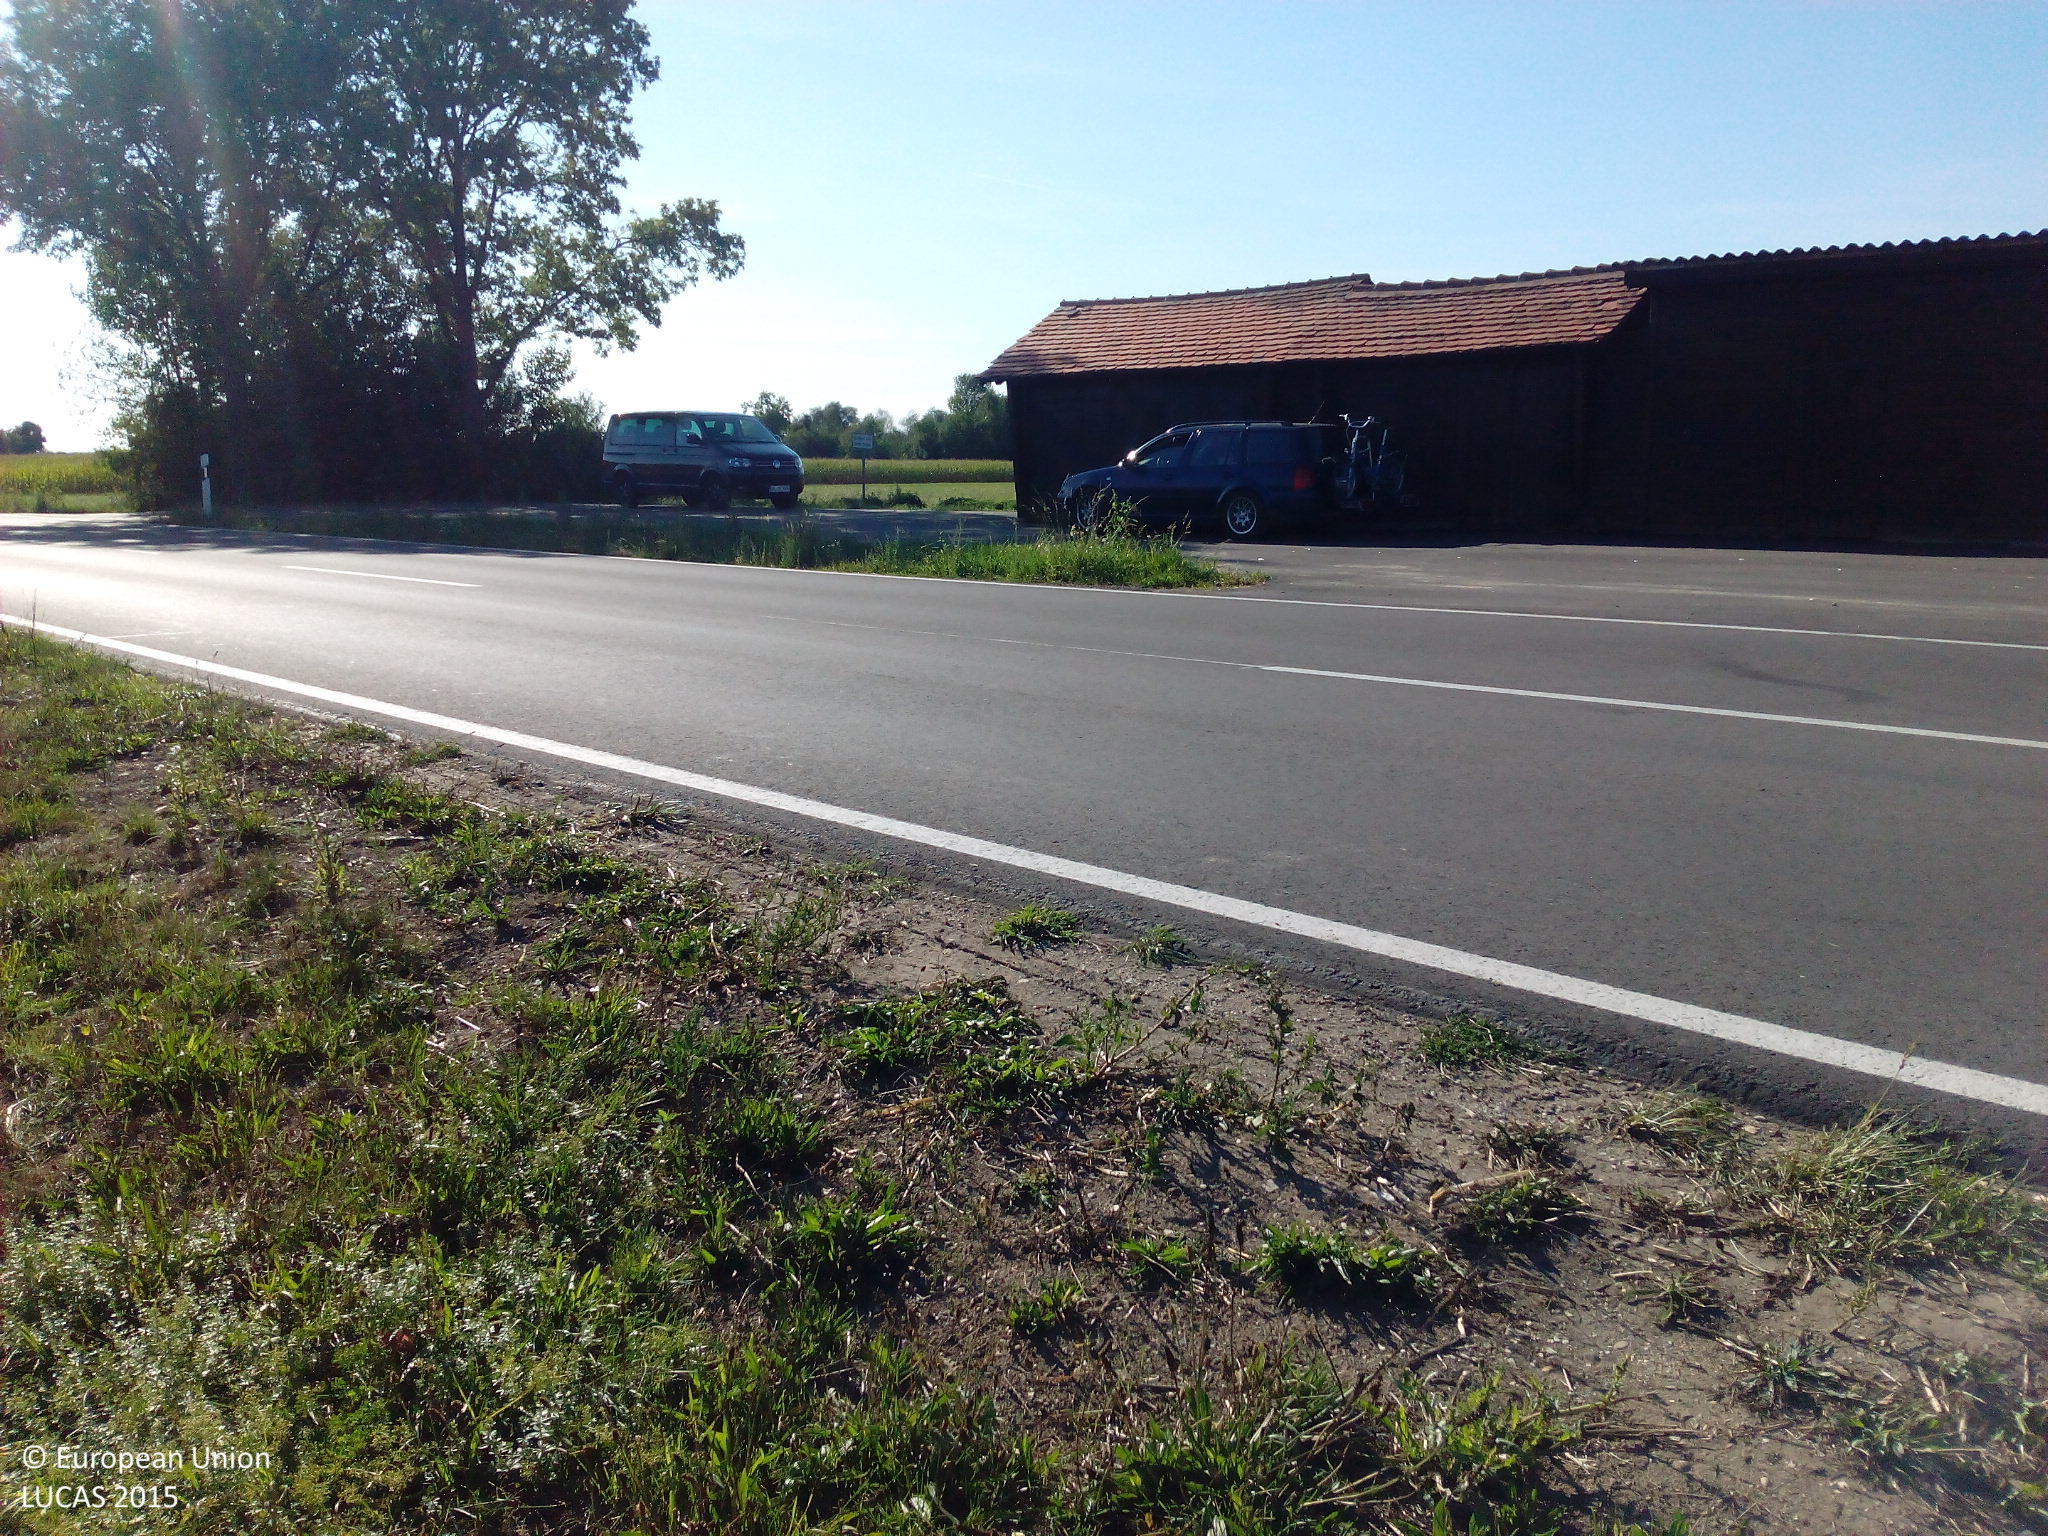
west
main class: Cropland
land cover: Maize
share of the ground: > 75 %
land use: Agriculture (excluding fallow land and kitchen gardens)
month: August
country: DE
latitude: 48.3315
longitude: 9.9596
